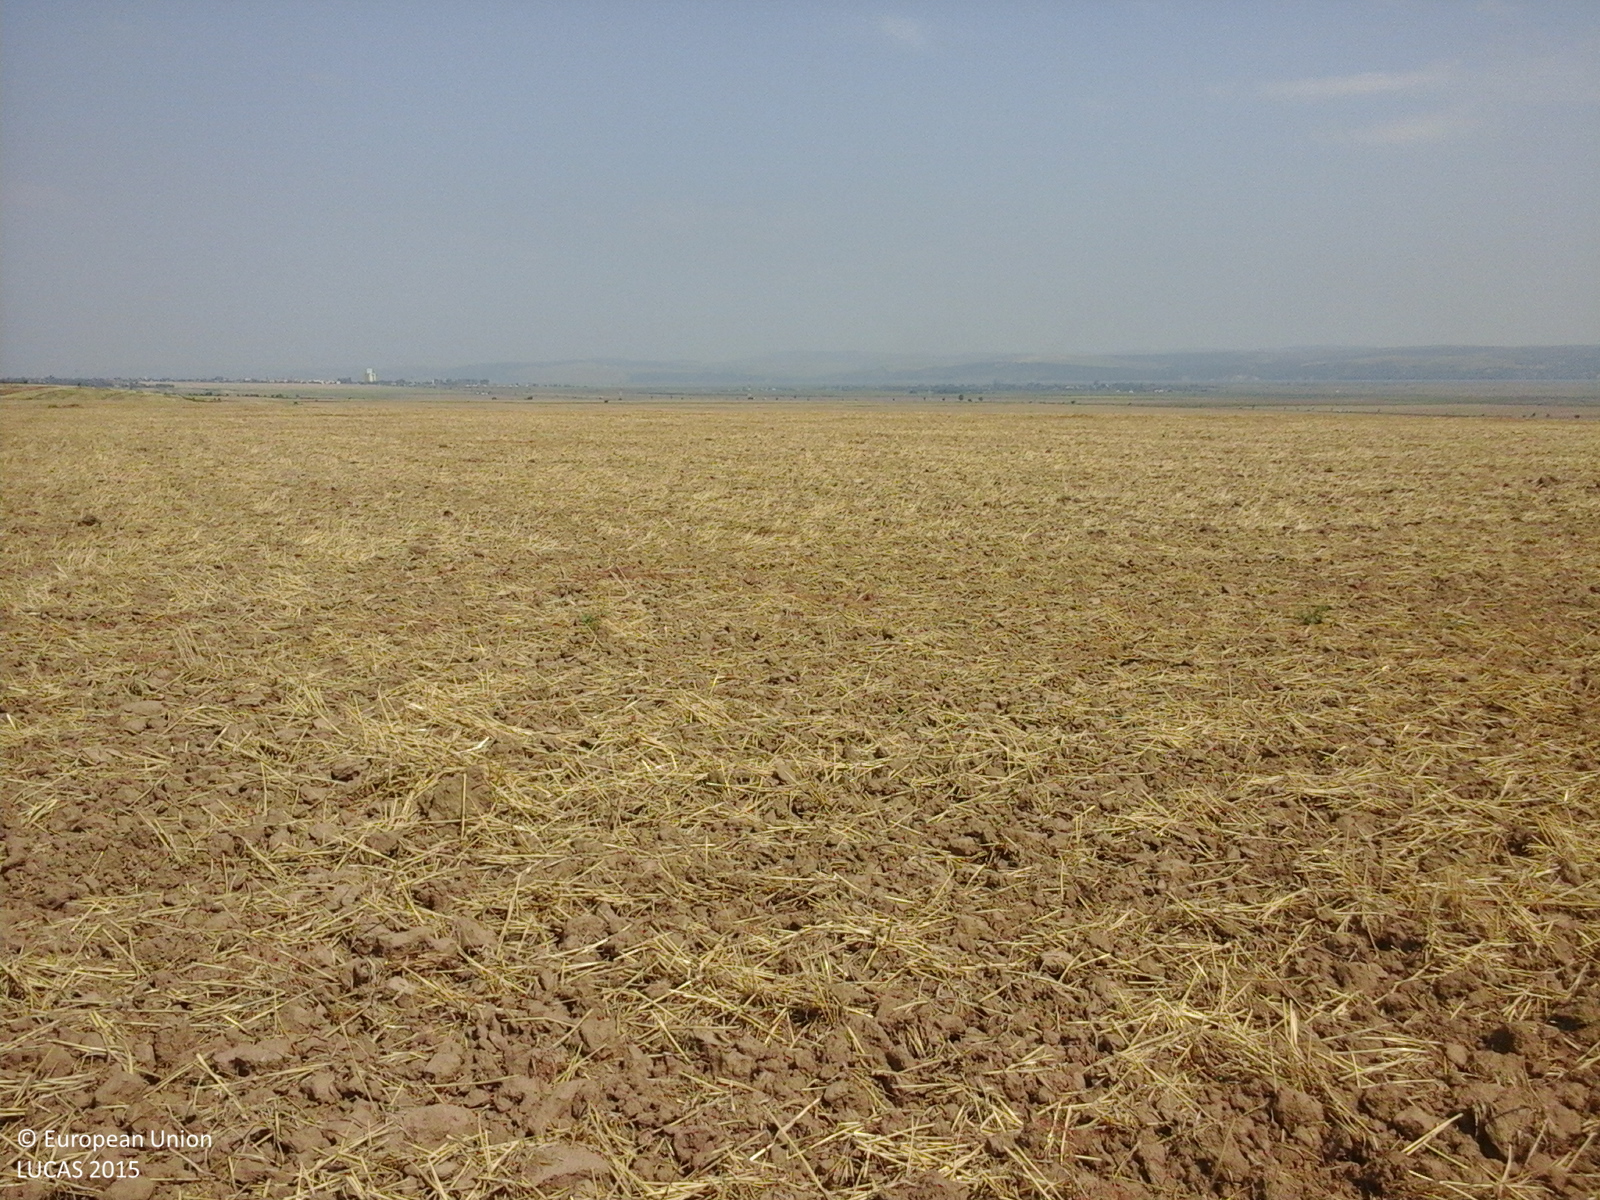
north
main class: Cropland
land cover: Common wheat
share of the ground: 10 - 25 %
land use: Agriculture (excluding fallow land and kitchen gardens)
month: August
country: RO
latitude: 46.1529
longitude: 27.1236
